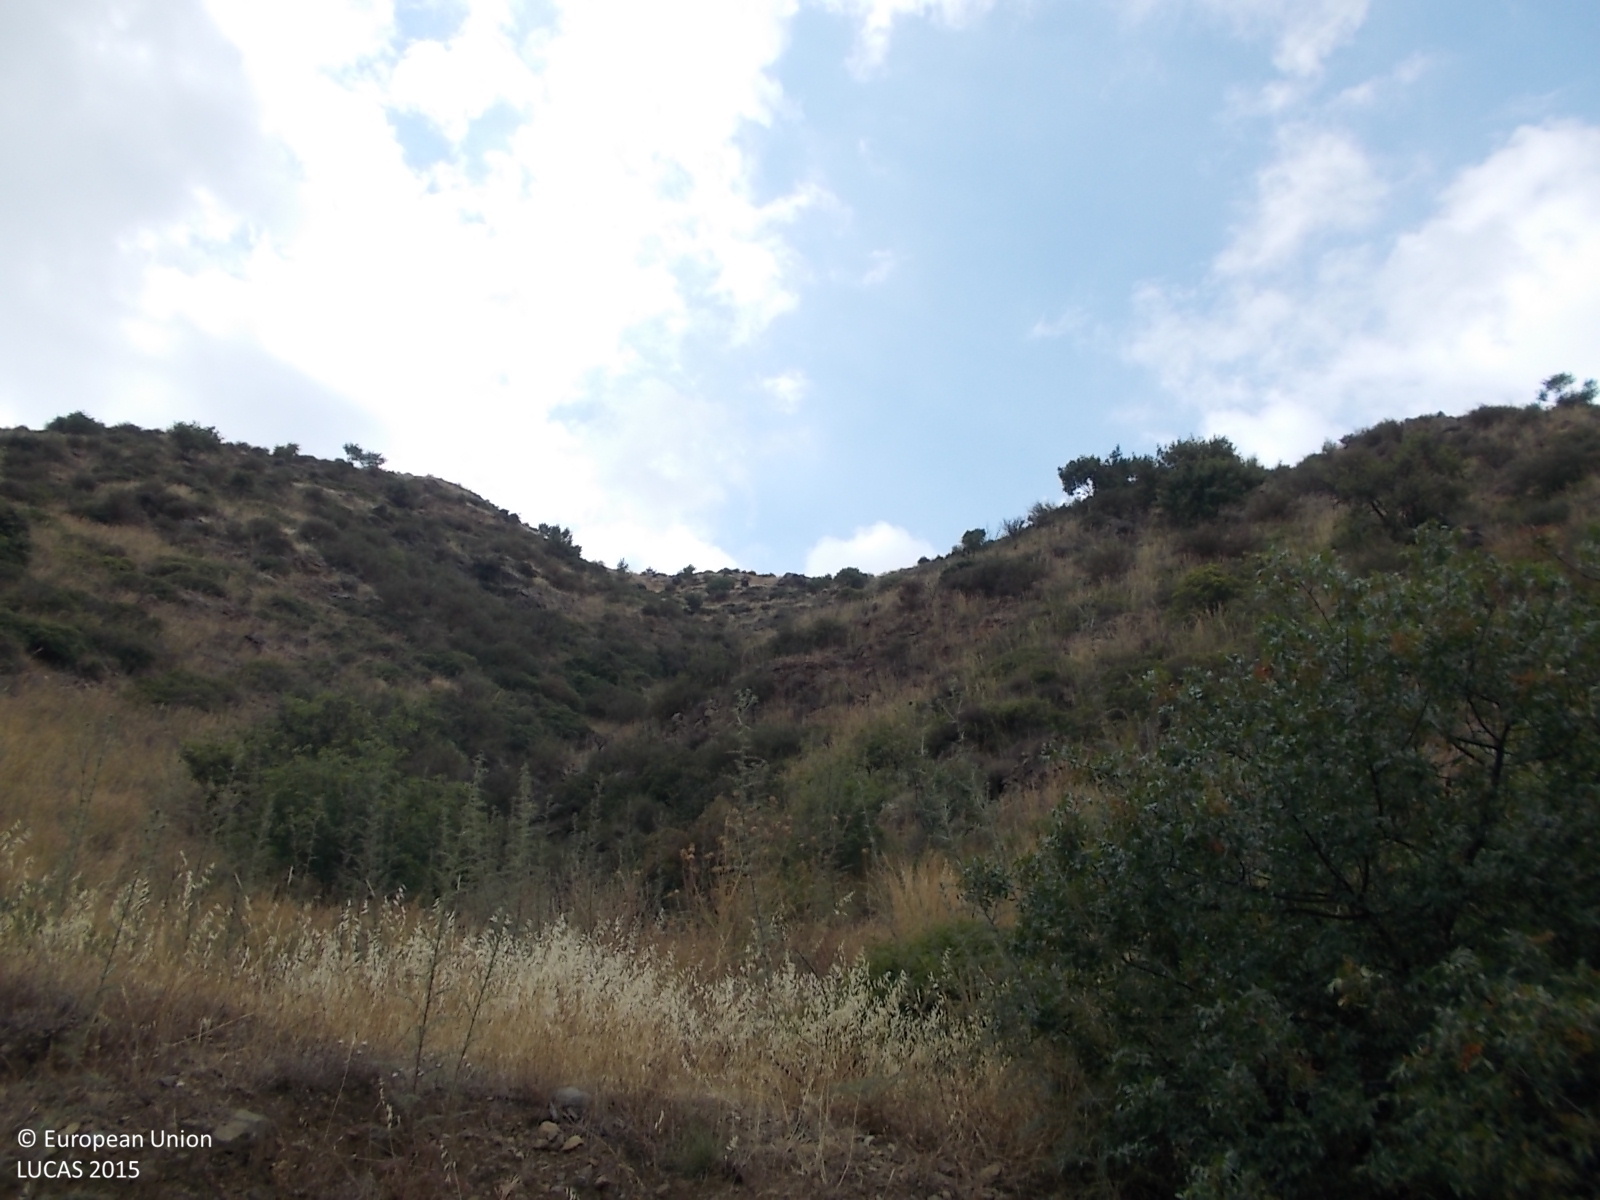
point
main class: Shrubland
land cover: Shrubland without tree cover
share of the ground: 25 - 50 %
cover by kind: shrubs 35 %, herbaceous plants 25 %, consolidated bare surface 20 %, unconsolidated bare surface 20 %
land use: Semi-natural and natural areas not in use
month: June
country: CY
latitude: 35.1611
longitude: 32.6607
